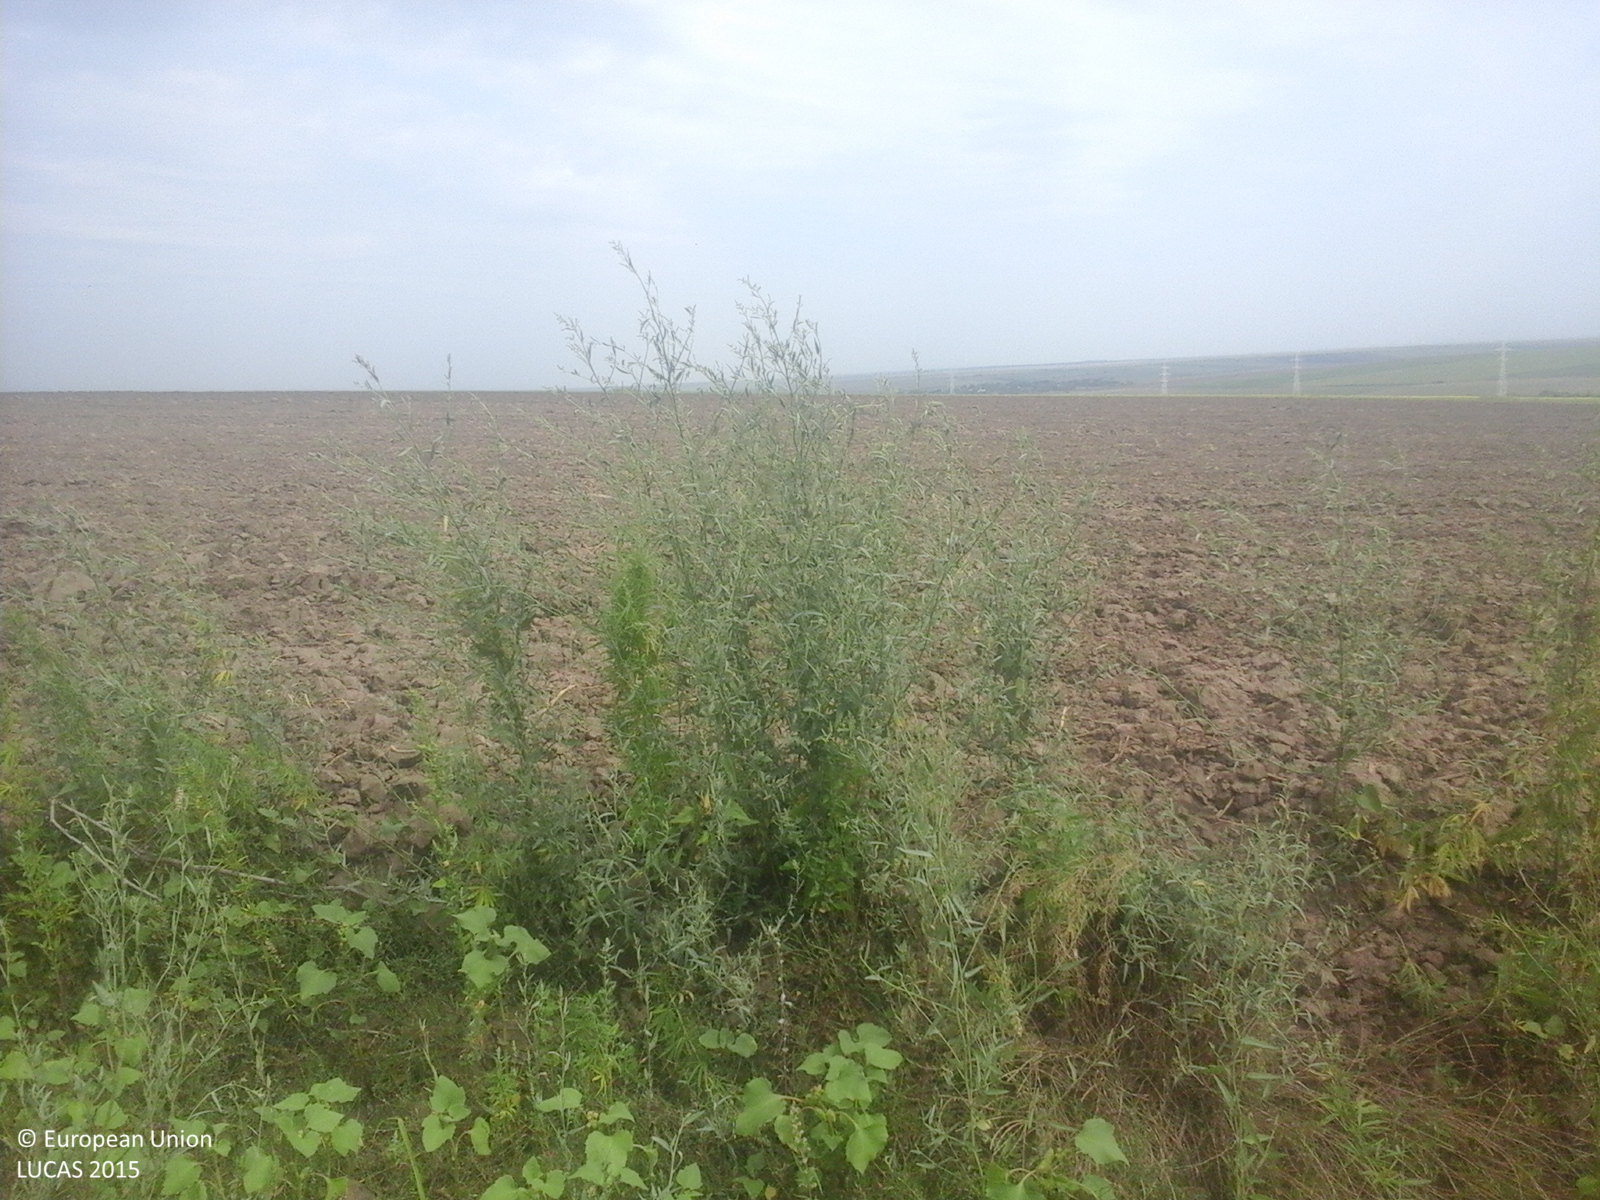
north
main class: Cropland
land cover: Sunflower
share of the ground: > 75 %
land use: Agriculture (excluding fallow land and kitchen gardens)
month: August
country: RO
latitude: 43.9231
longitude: 28.2042
